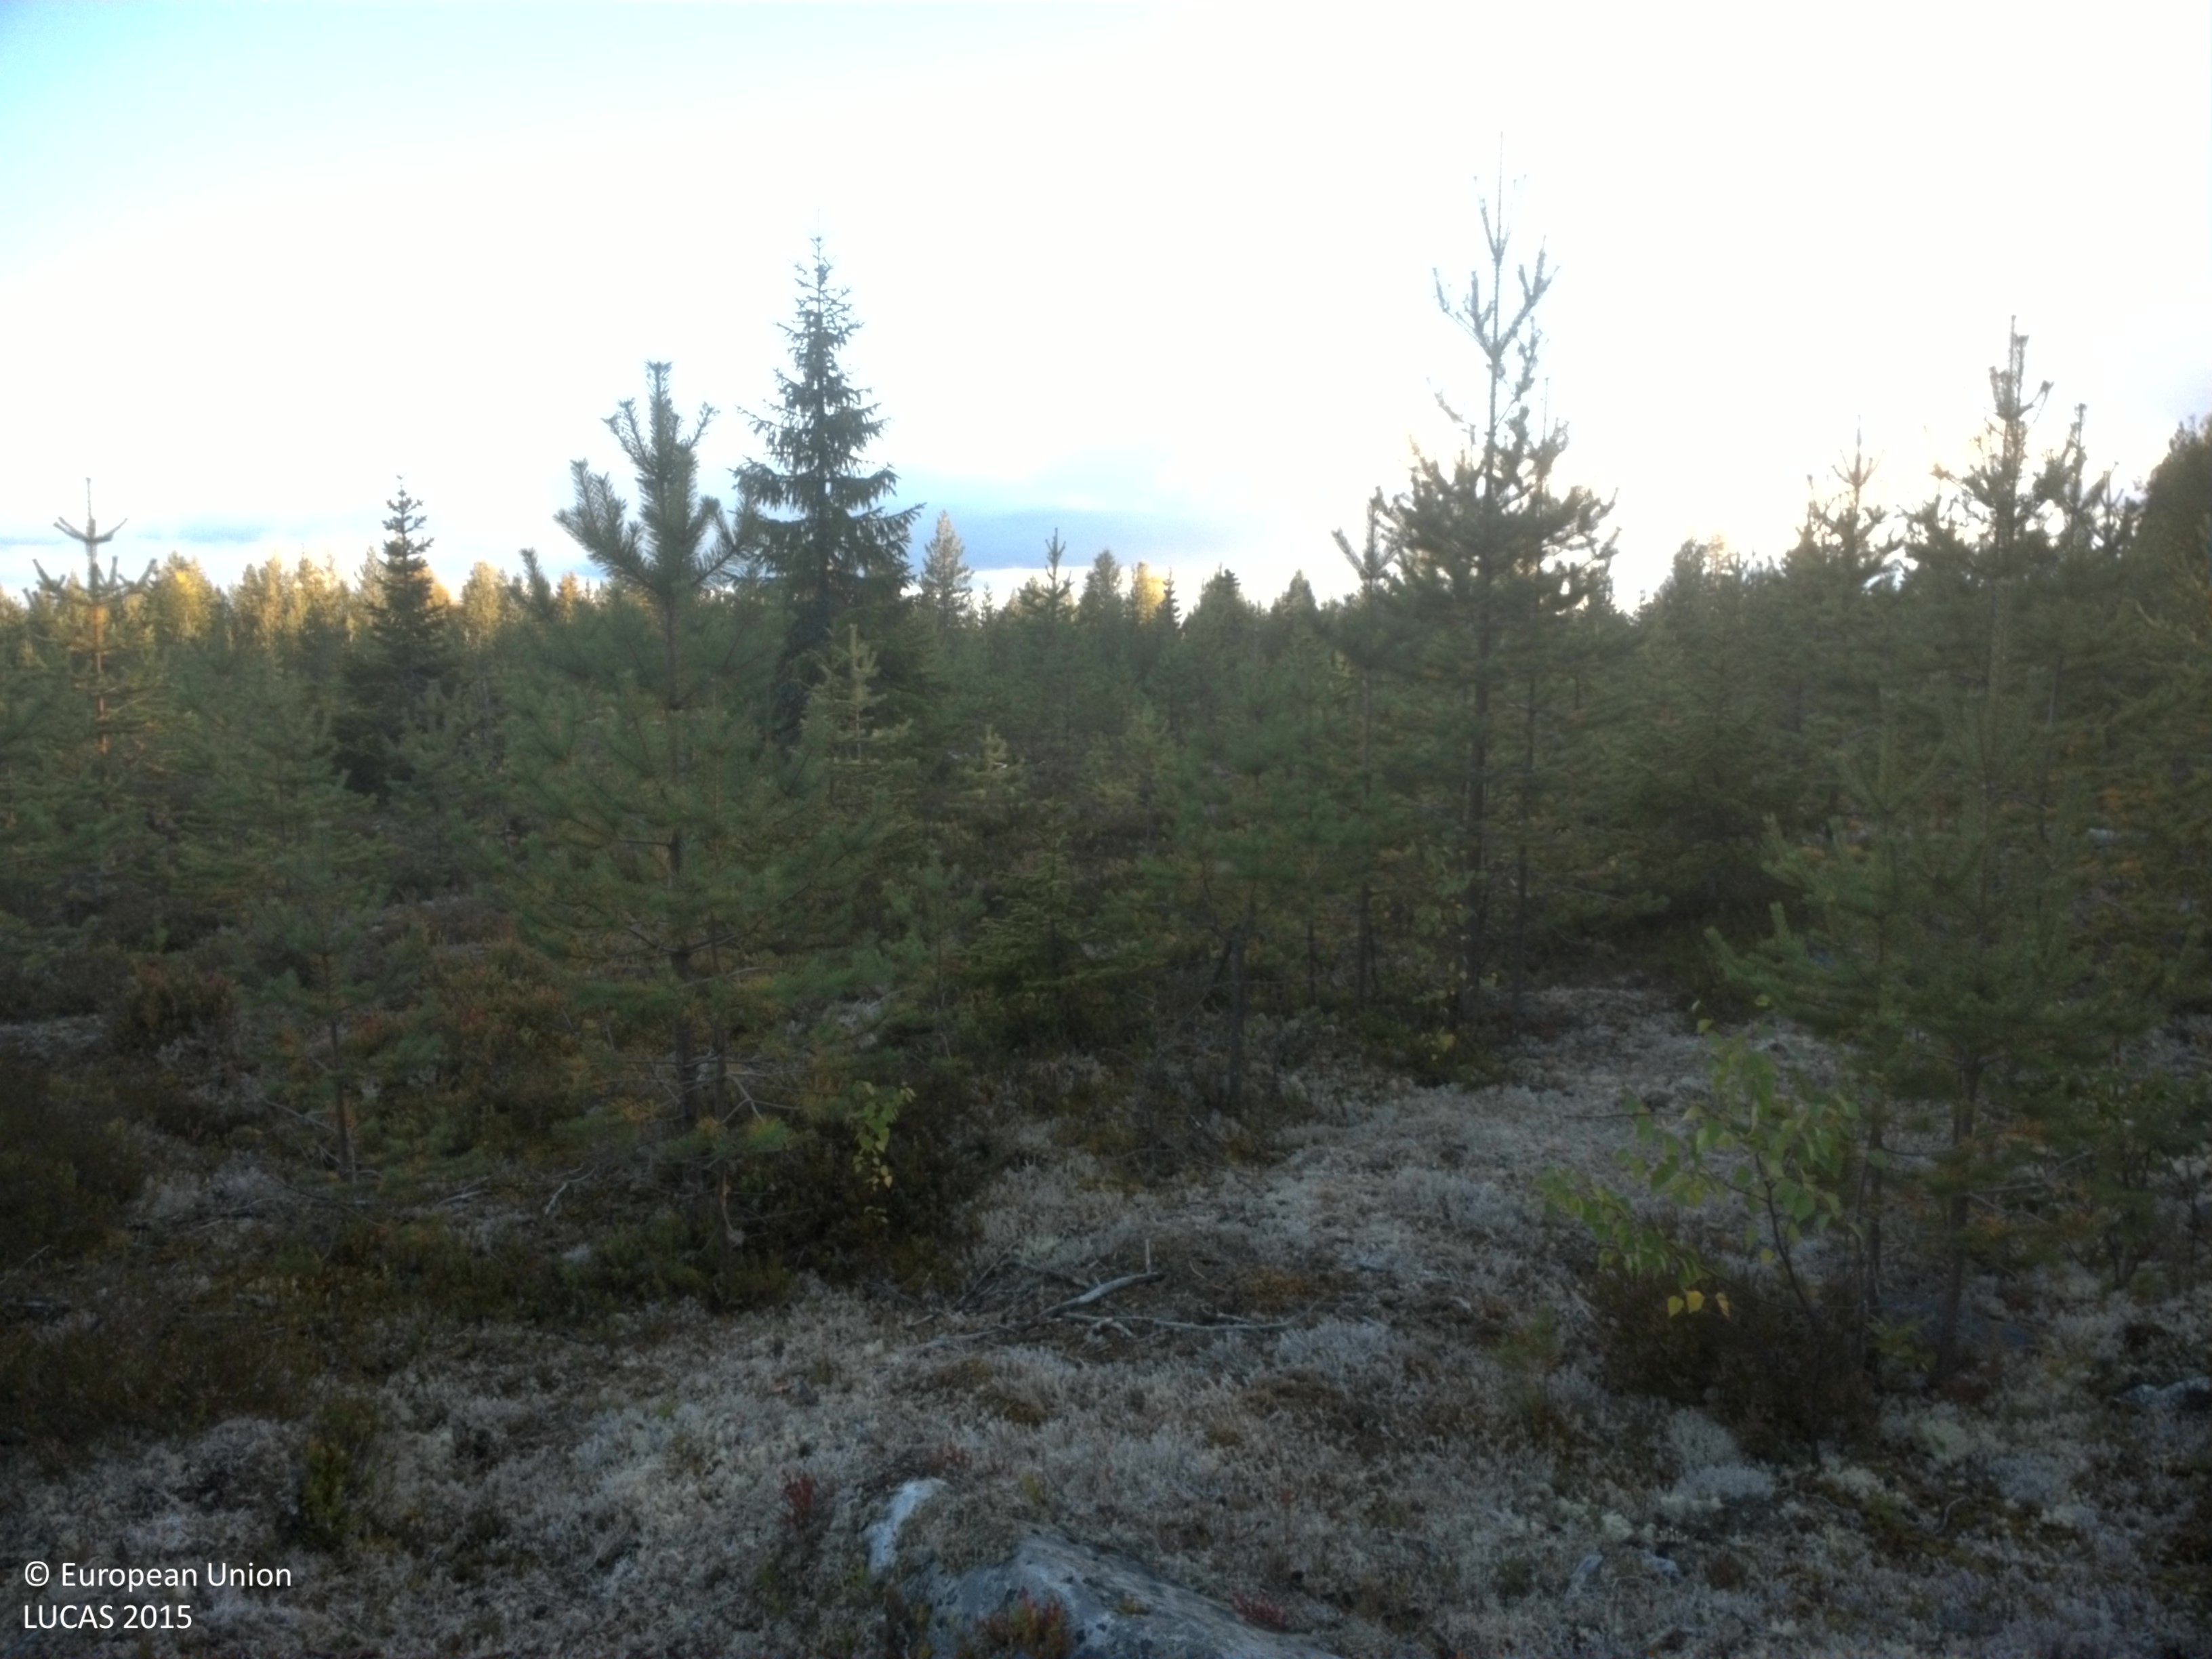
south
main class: Woodland
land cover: Pine dominated coniferous woodland
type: boreal forest
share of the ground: 25 - 50 %
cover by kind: coniferous forest trees 40 %, shrubs 30 %, lichens and mosses 30 %
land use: Forestry
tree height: > 5 m
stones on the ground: > 50 %
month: September
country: SE
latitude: 64.3923
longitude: 19.6991
